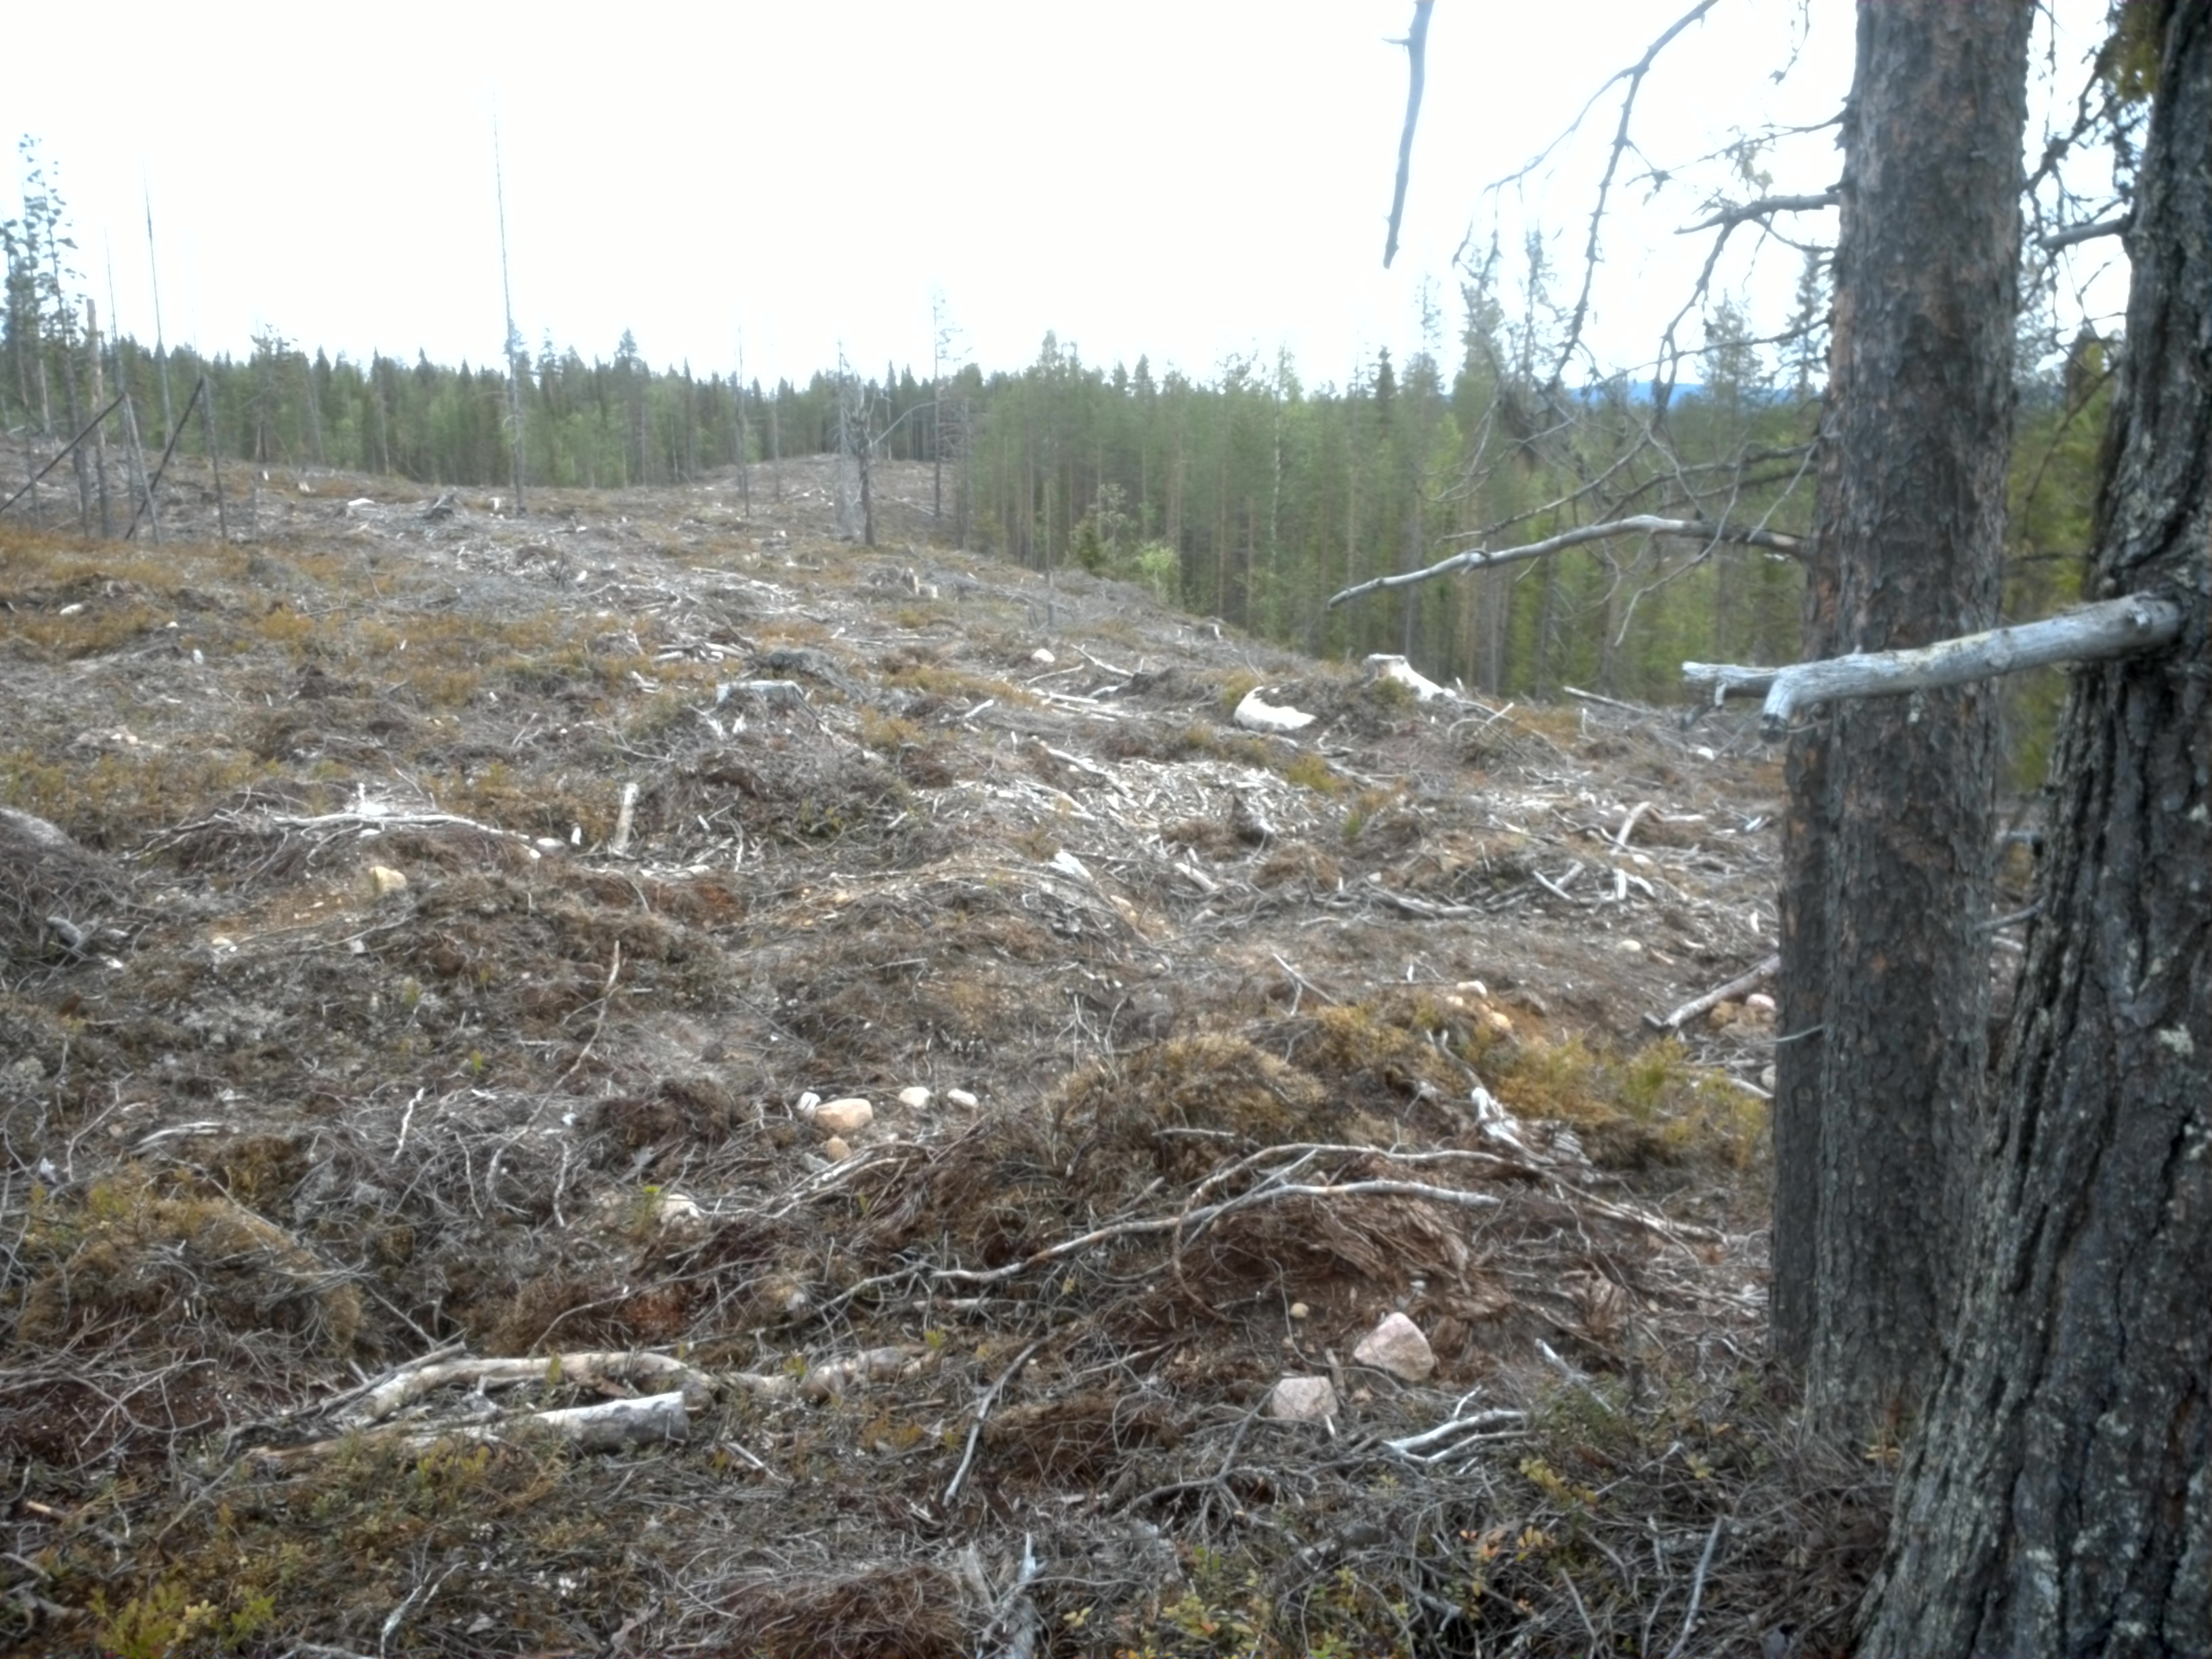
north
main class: Shrubland
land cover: Shrubland with sparse tree cover
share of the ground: 50 - 75 %
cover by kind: shrubs 60 %, unconsolidated bare surface 35 %, coniferous forest trees 5 %
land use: Forestry
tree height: > 5 m
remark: Clear cut
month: June
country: SE
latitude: 66.9980
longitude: 21.8148
